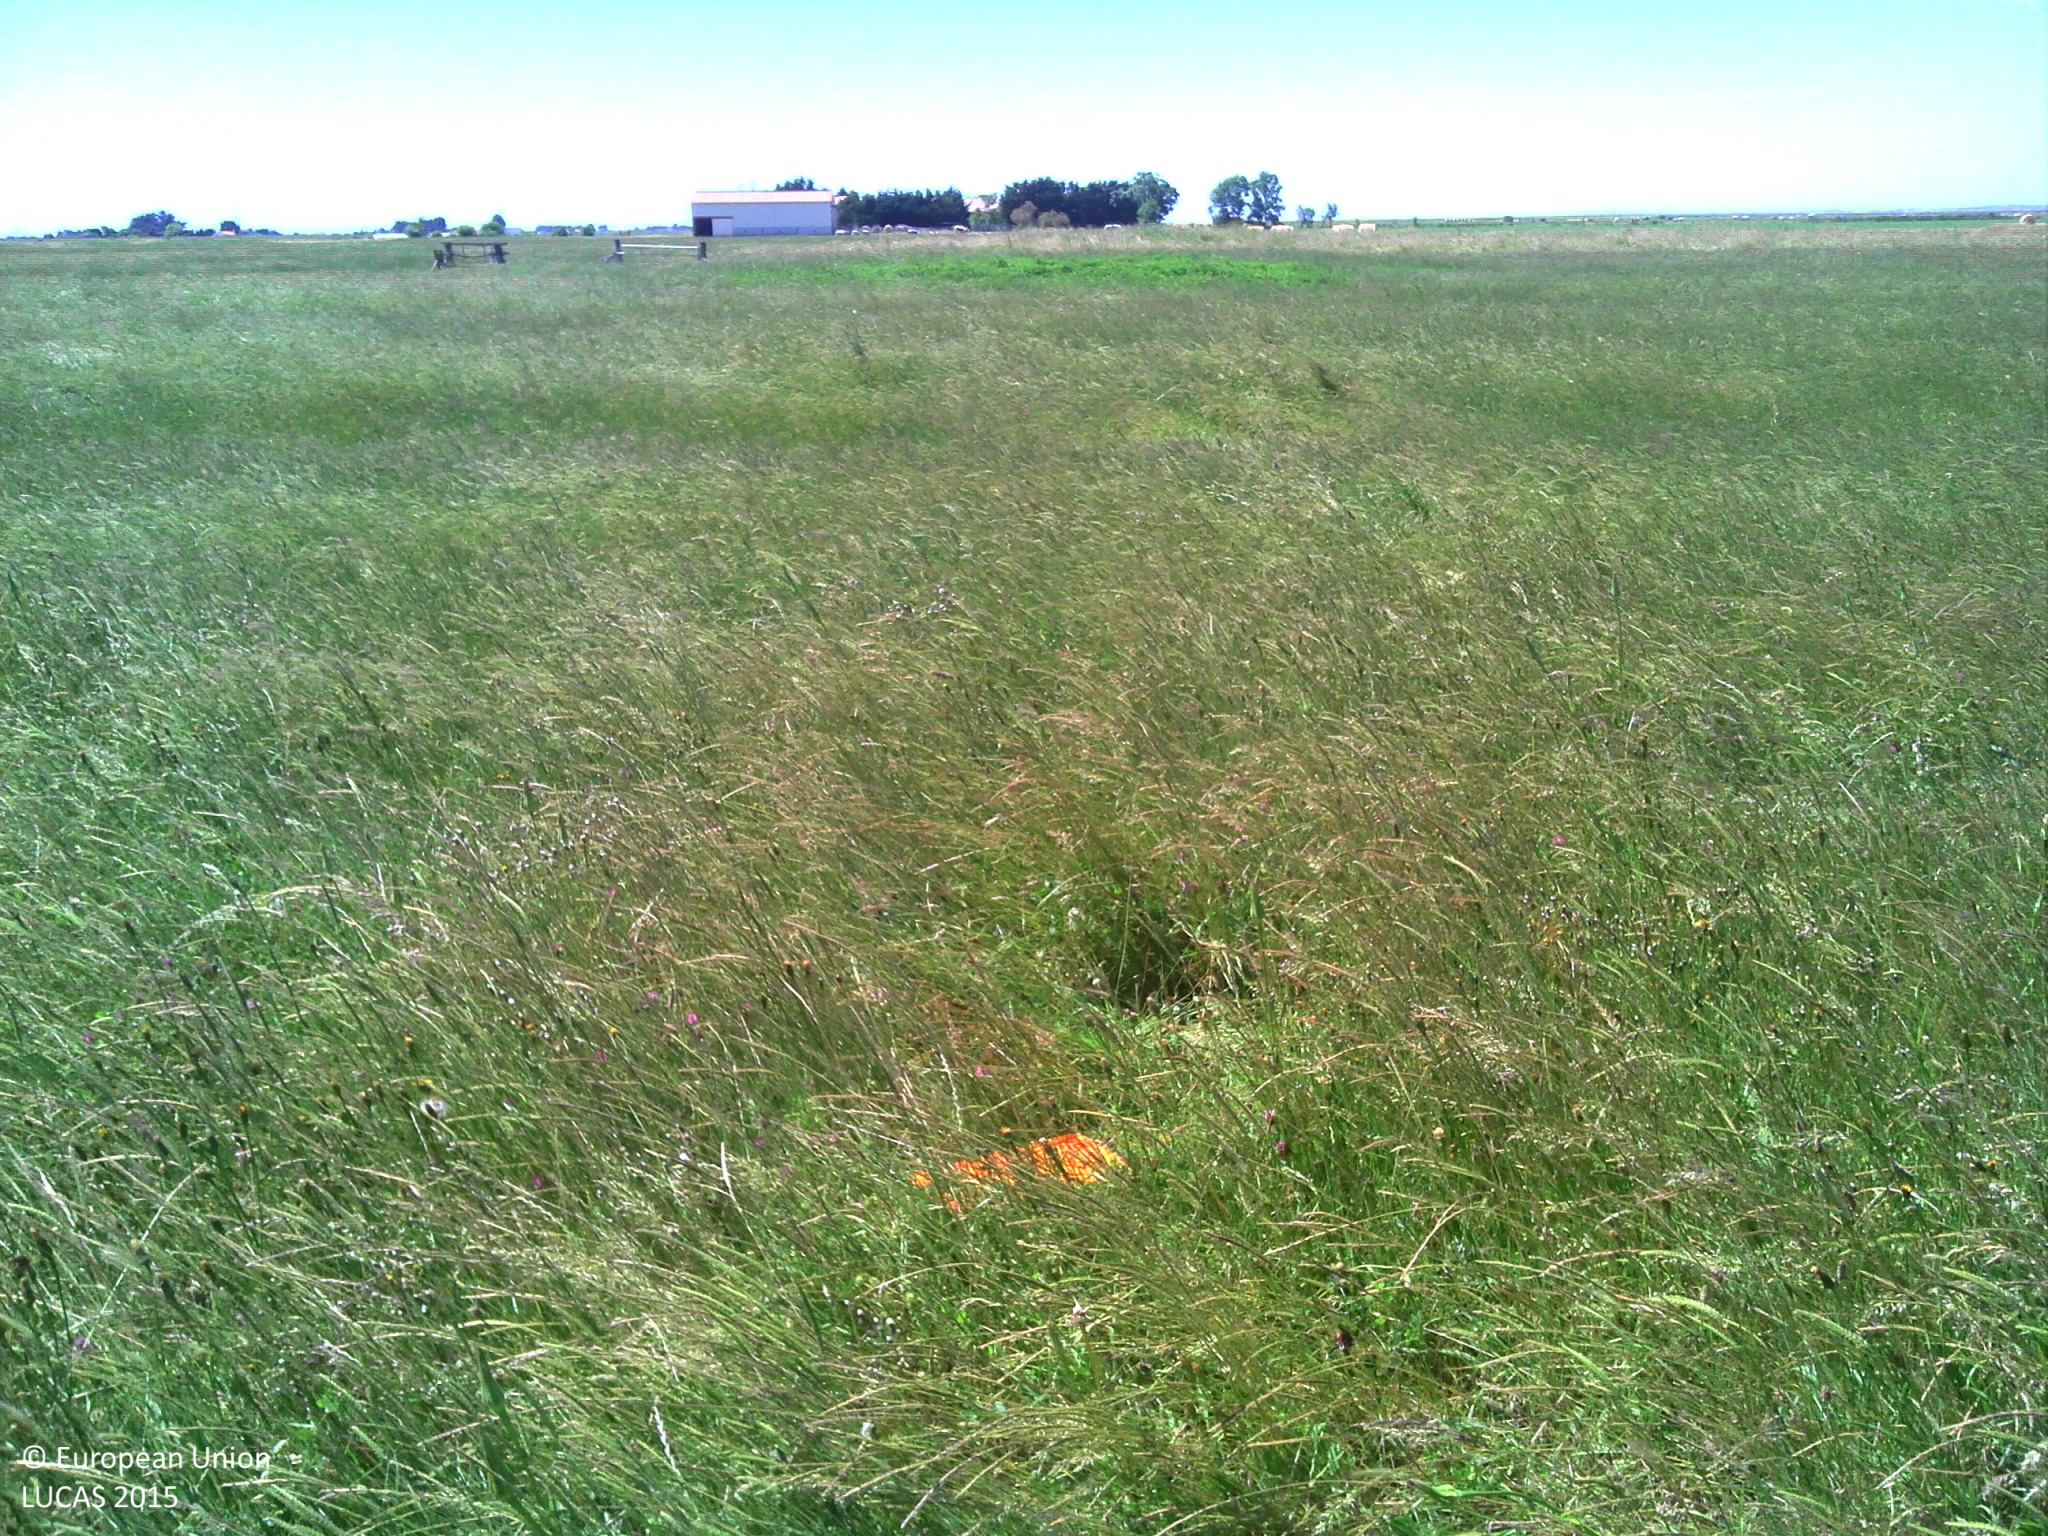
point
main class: Grassland
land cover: Grassland without tree/shrub cover
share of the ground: > 75 %
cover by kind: herbaceous plants 100 %
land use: Agriculture (excluding fallow land and kitchen gardens)
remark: Temporary flooded
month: June
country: FR
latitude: 47.0041
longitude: -1.9757
